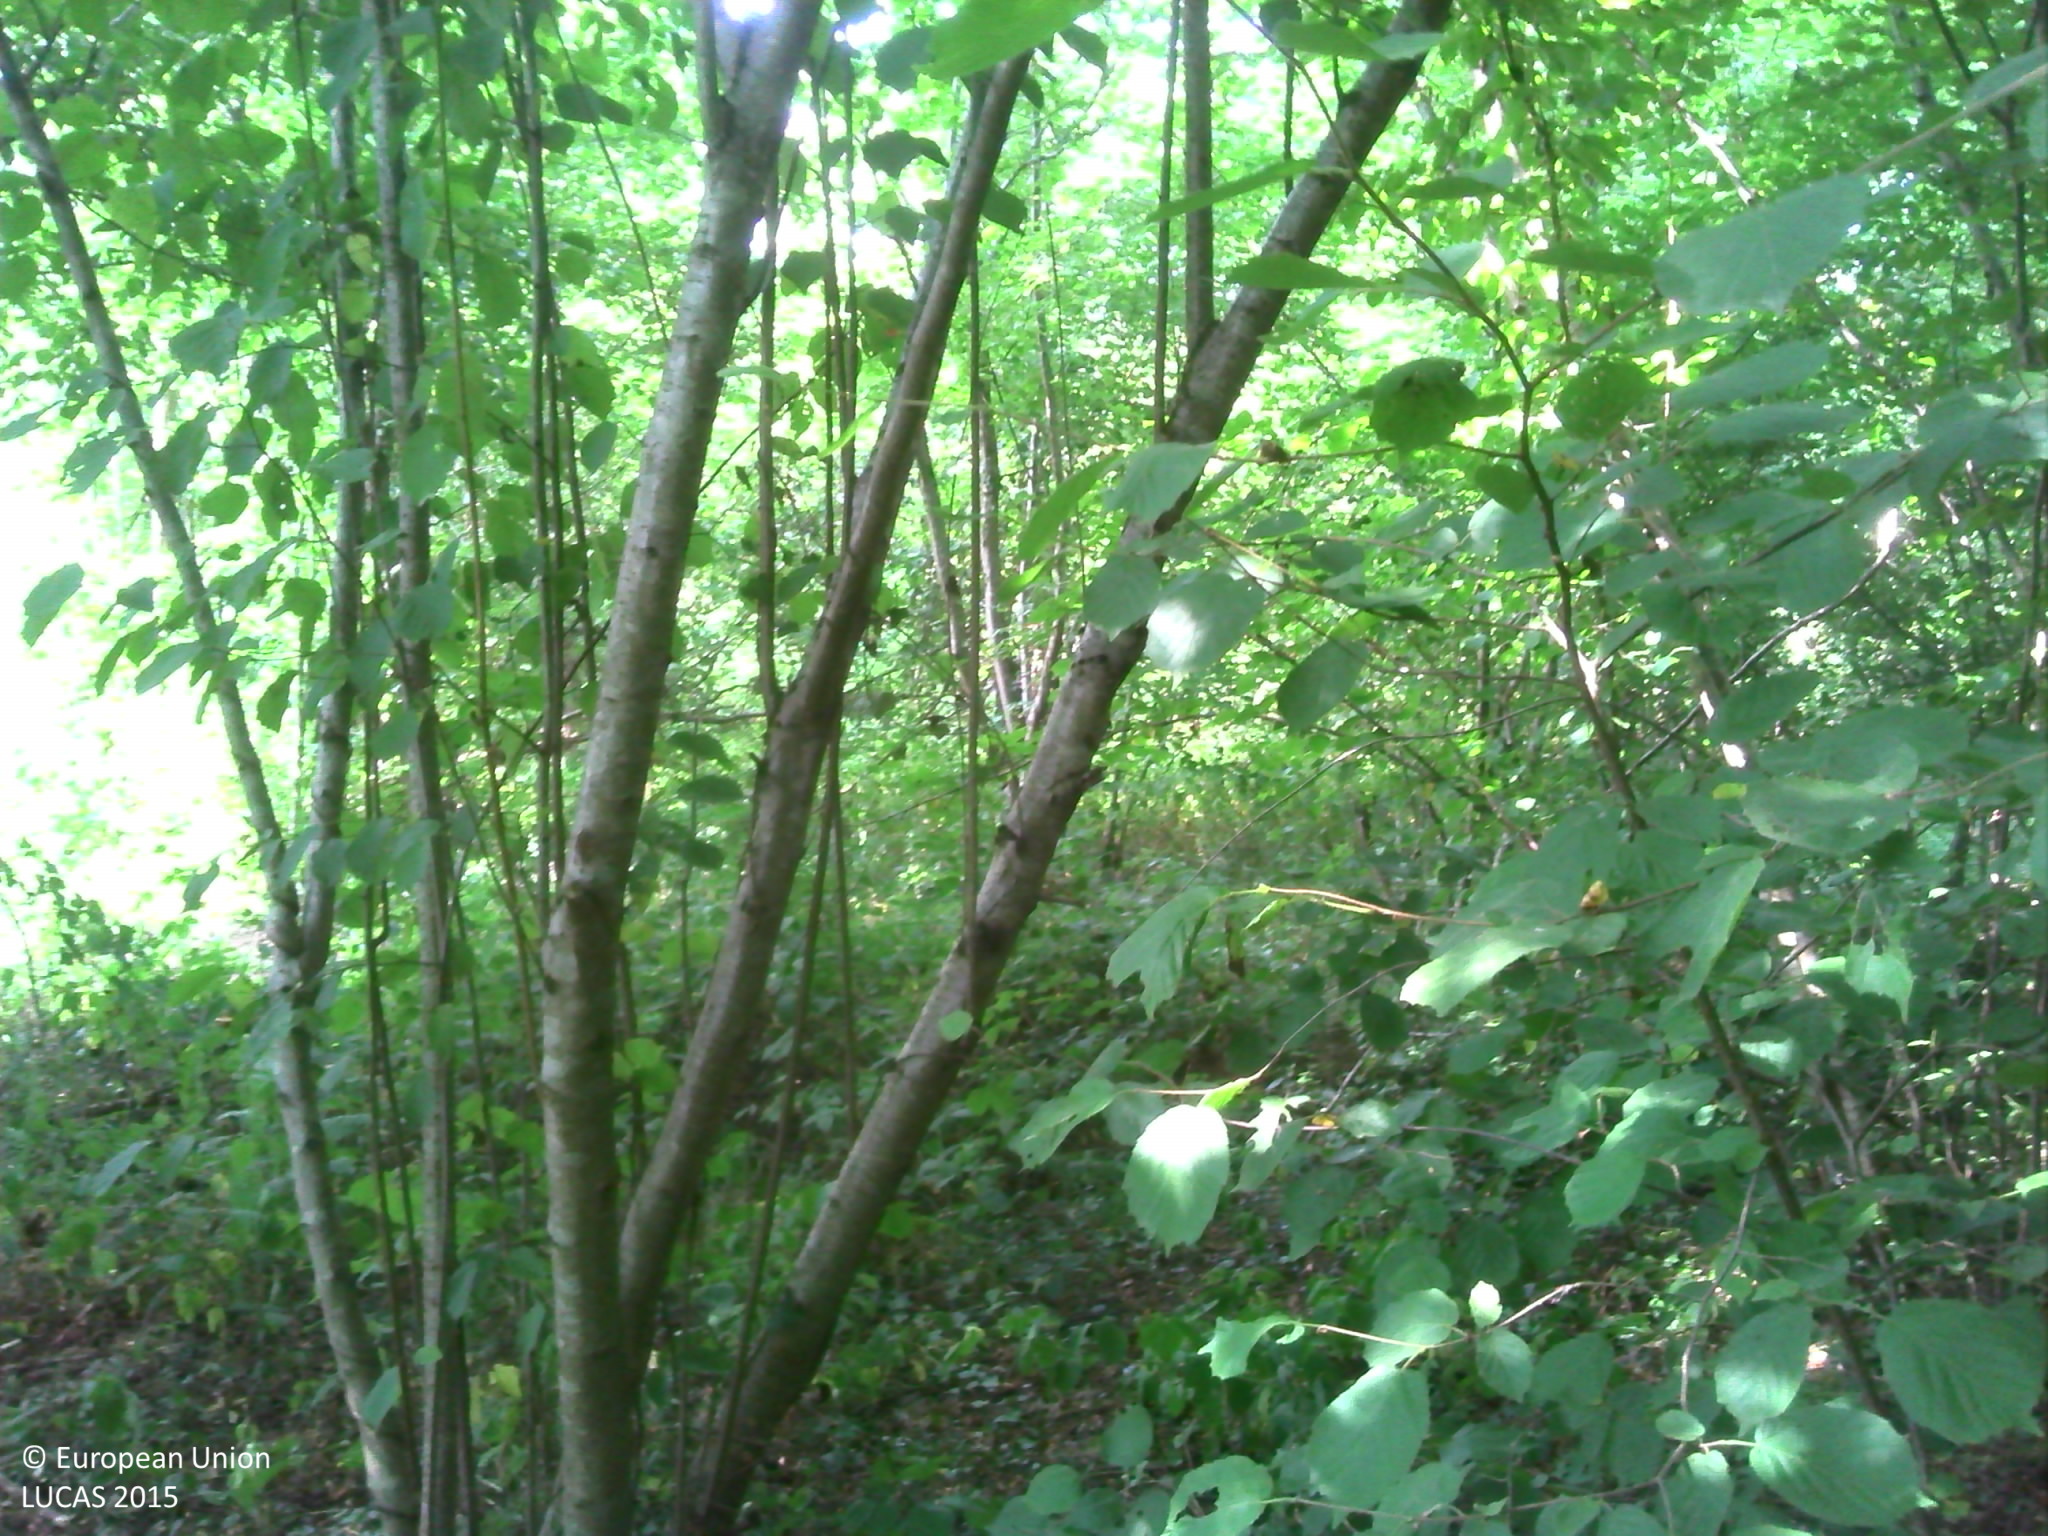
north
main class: Woodland
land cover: Broadleaved woodland
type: mesophytic deciduous forest
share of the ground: > 75 %
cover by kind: broadleaved forest trees 85 %, herbaceous plants 10 %, shrubs 5 %
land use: Forestry
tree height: > 5 m
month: July
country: FR
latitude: 46.8348
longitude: 5.1112
